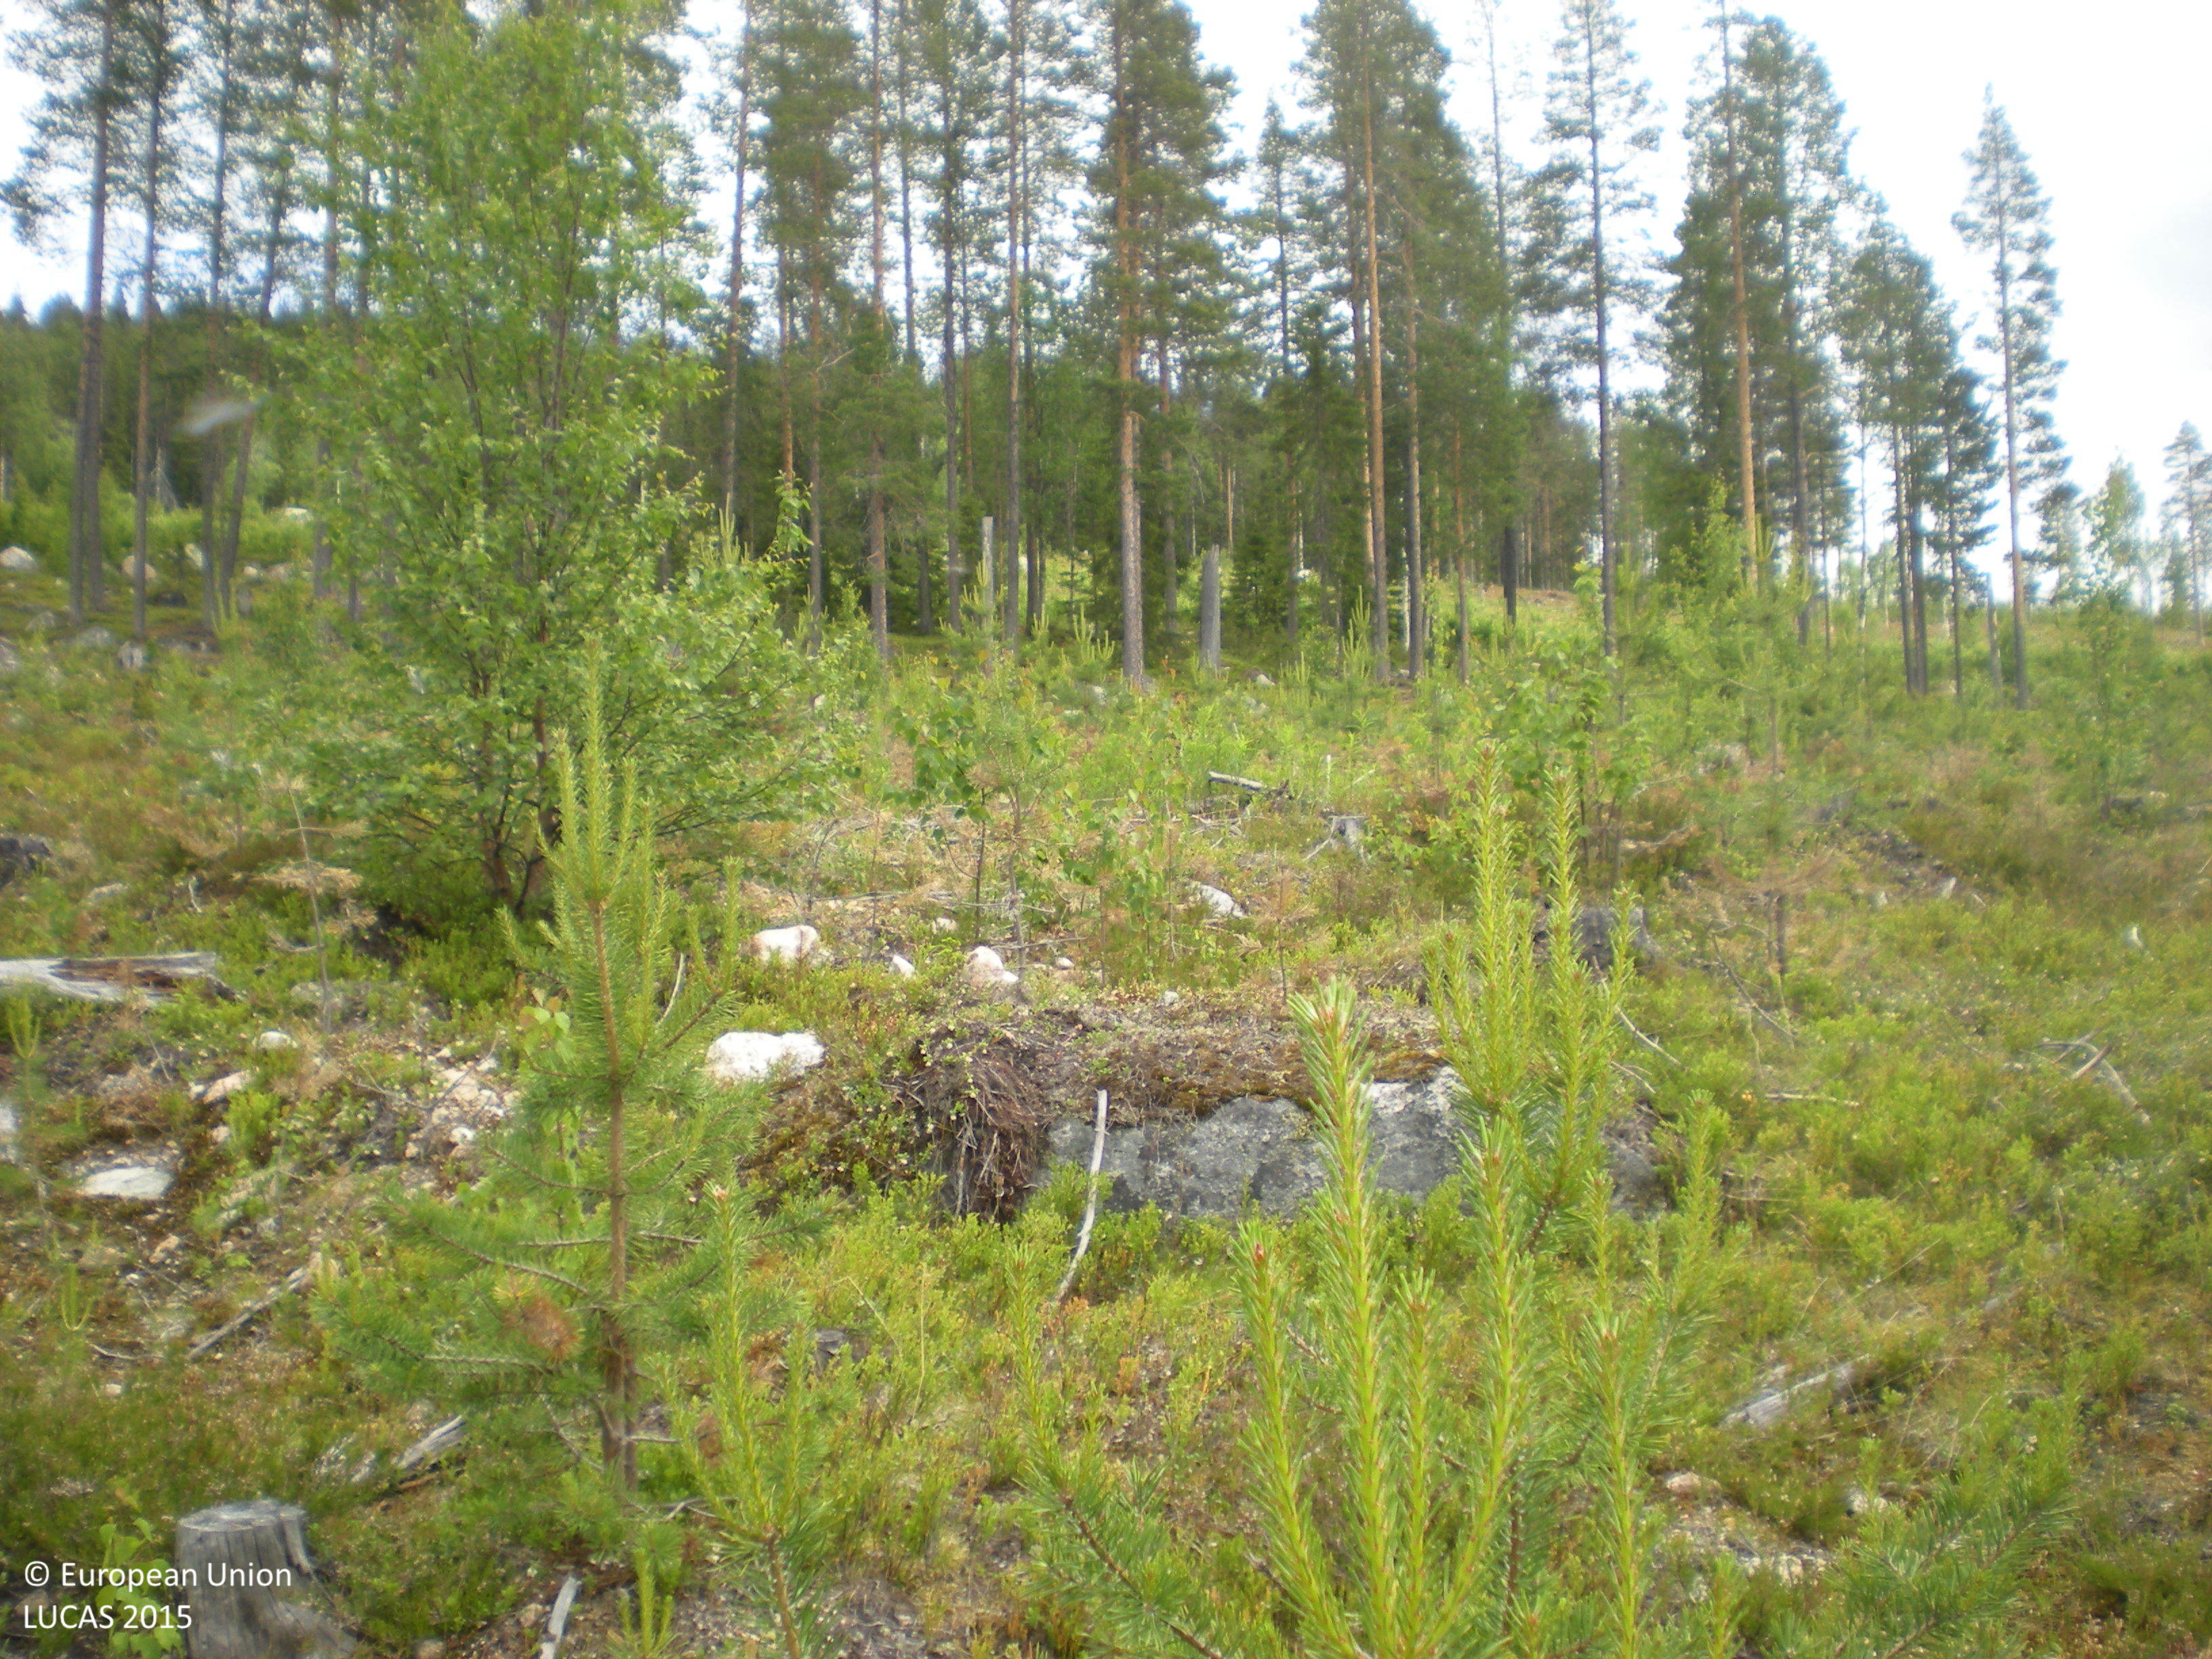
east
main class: Woodland
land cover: Pine dominated mixed woodland
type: boreal forest
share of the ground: 10 - 25 %
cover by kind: shrubs 60 %, coniferous forest trees 15 %, lichens and mosses 15 %, broadleaved forest trees 10 %
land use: Forestry
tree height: < 5 m
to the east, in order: Pine dominated mixed woodland; Pine dominated coniferous woodland; Broadleaved woodland; Paved roads, cycling and walking lanes; Ditches and canals; Pine dominated mixed woodland; Other coniferous woodland
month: July
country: SE
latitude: 65.3983
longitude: 17.9472
